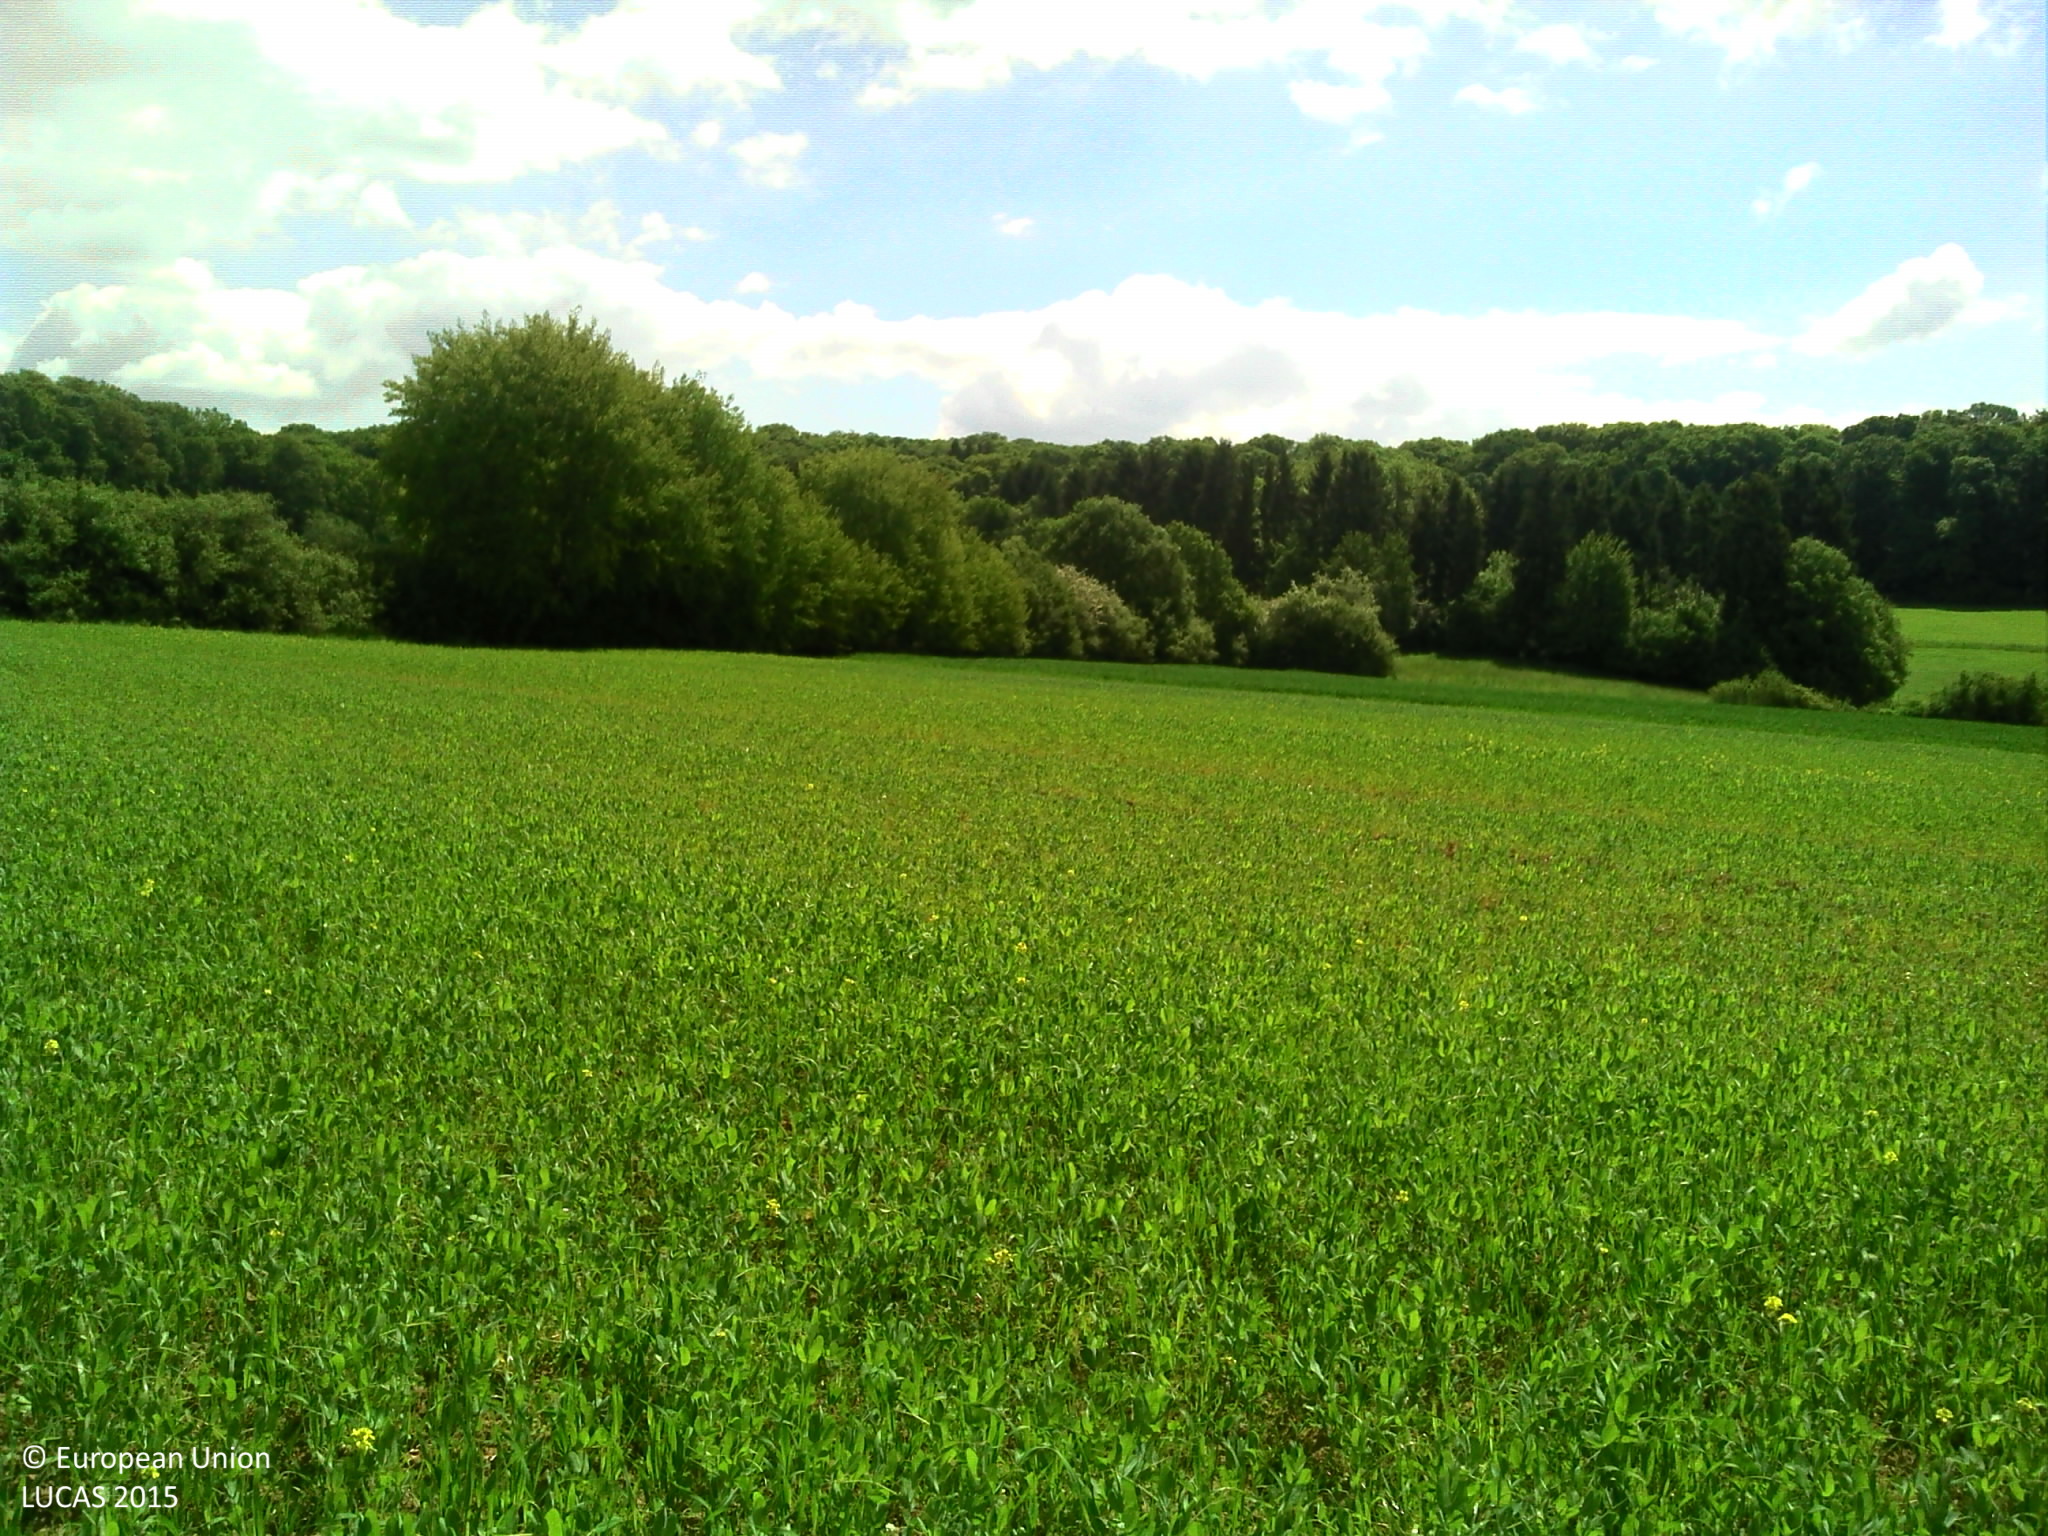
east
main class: Cropland
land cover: Other leguminous and mixtures for fodder
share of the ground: > 75 %
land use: Agriculture (excluding fallow land and kitchen gardens)
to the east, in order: Other leguminous and mixtures for fodder; Electric lines; Other leguminous and mixtures for fodder; Grass margins; Abandoned hedges; Grass margins; Maize
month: May
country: LU
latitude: 49.5570
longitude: 6.0318
